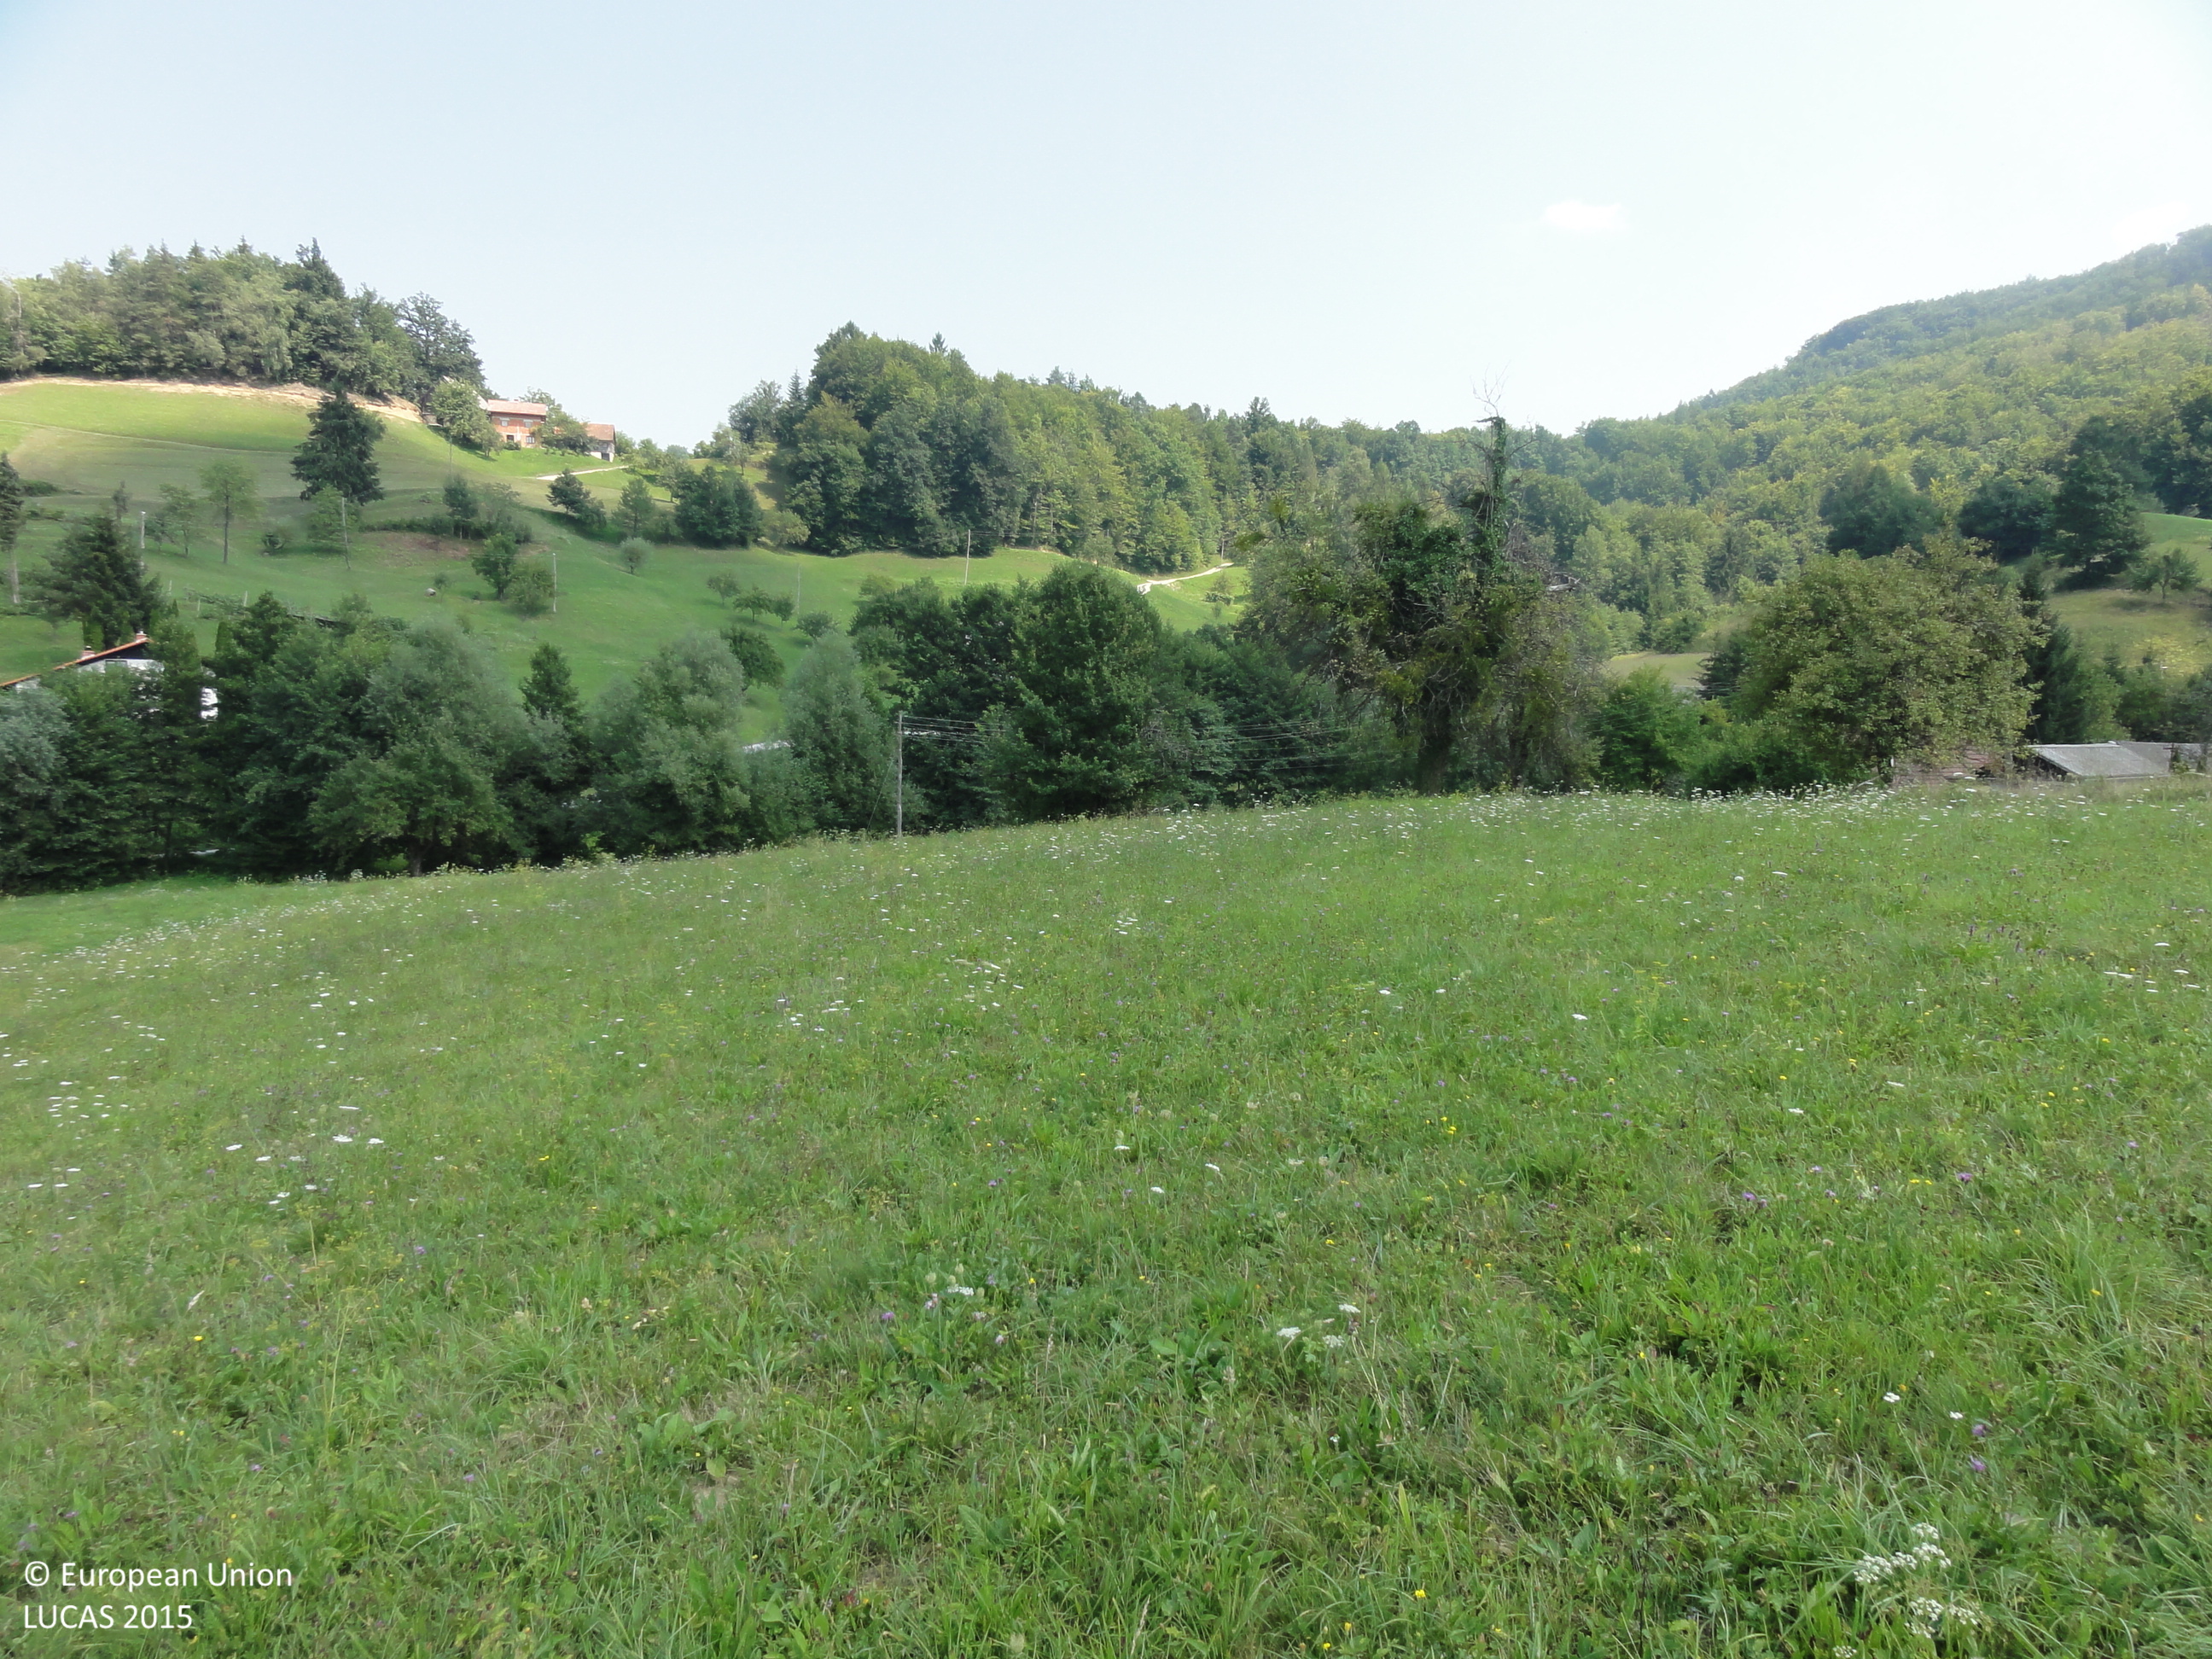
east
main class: Grassland
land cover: Grassland without tree/shrub cover
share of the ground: > 75 %
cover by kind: herbaceous plants 100 %
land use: Agriculture (excluding fallow land and kitchen gardens)
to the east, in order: Grassland without tree/shrub cover; Temporary grasslands; Grassland without tree/shrub cover; Abandoned hedges; Rivers and streams; Abandoned hedges; Electric lines; Grassland without tree/shrub cover; Other fresh vegetables; Paved roads, cycling and walking lanes; Grass margins; Ditches and canals; Grassland with sparse tree/shrub cover; Tracks; Grassland with sparse tree/shrub cover; Apple fruit; Grassland without tree/shrub cover; Electric lines; Grassland without tree/shrub cover
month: August
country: SI
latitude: 46.1375
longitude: 15.4992
